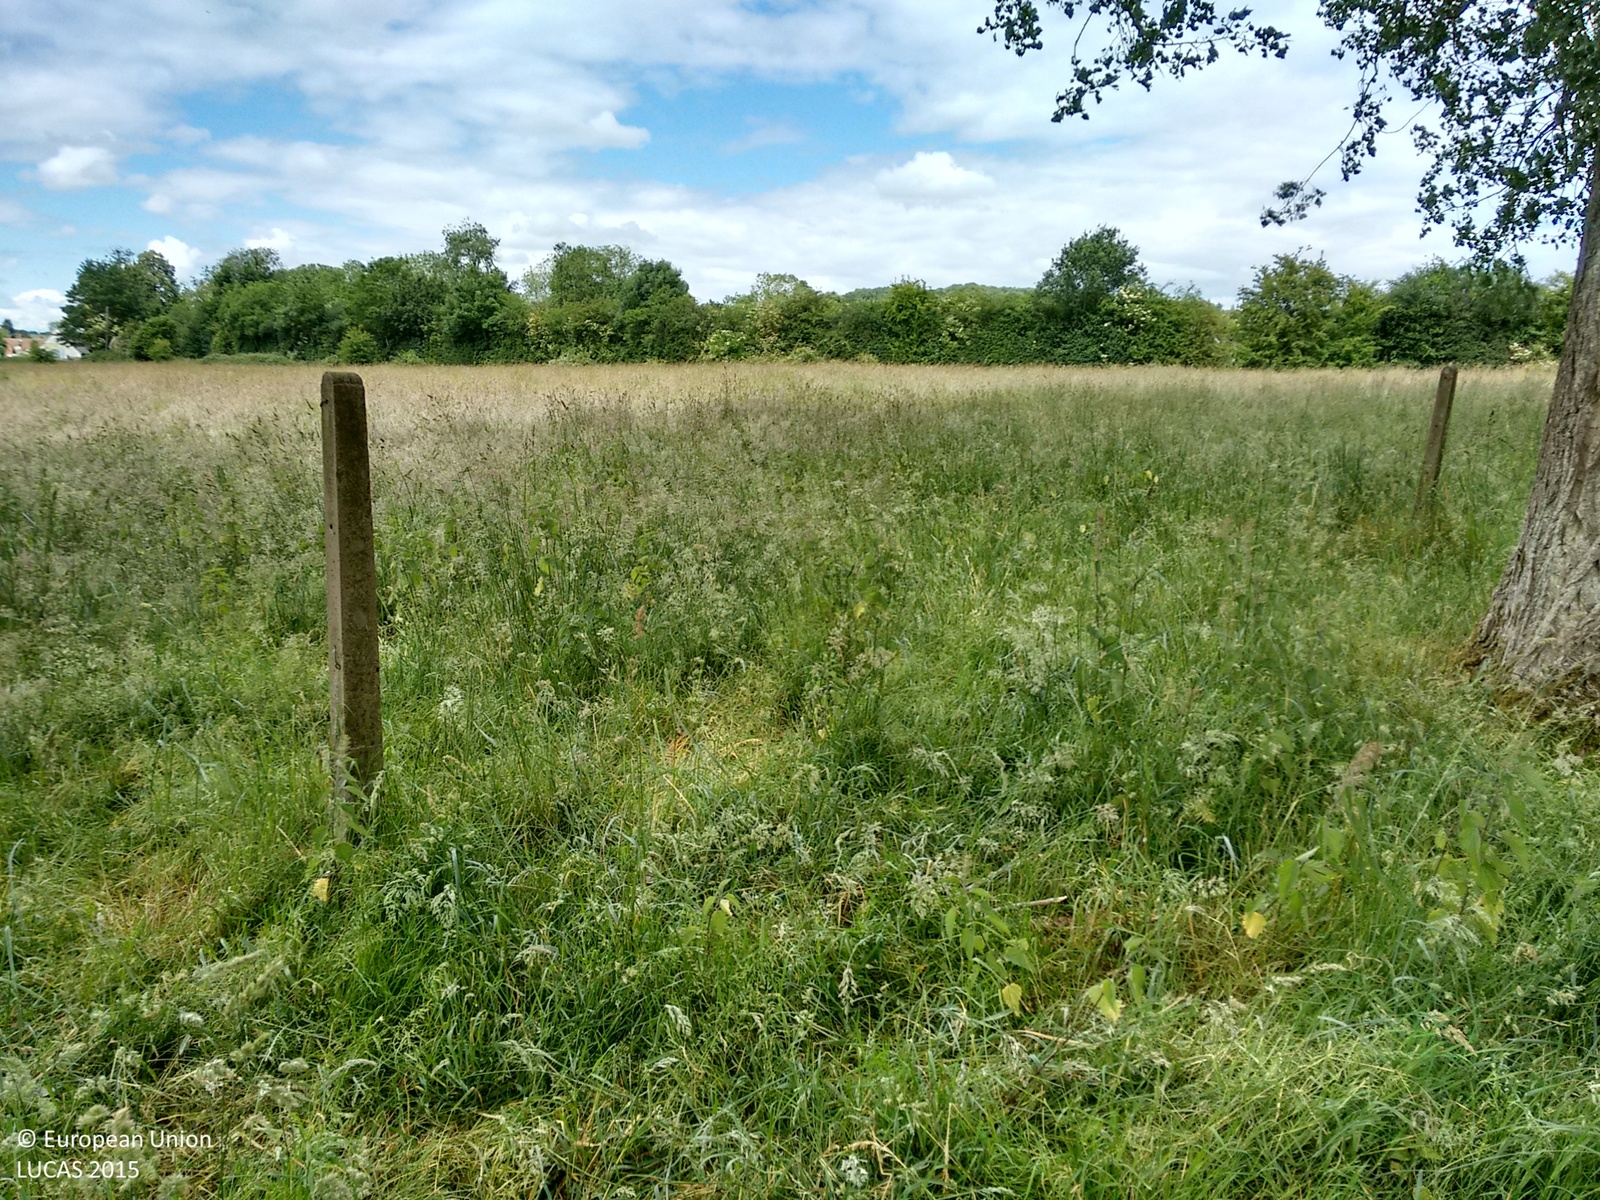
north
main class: Woodland
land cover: Broadleaved woodland
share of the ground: > 75 %
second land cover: Grassland without tree/shrub cover
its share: 10 - 25 %
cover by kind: broadleaved forest trees 80 %, herbaceous plants 20 %
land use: Waste treatment
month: June
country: GB
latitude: 51.4790
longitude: -1.2355
